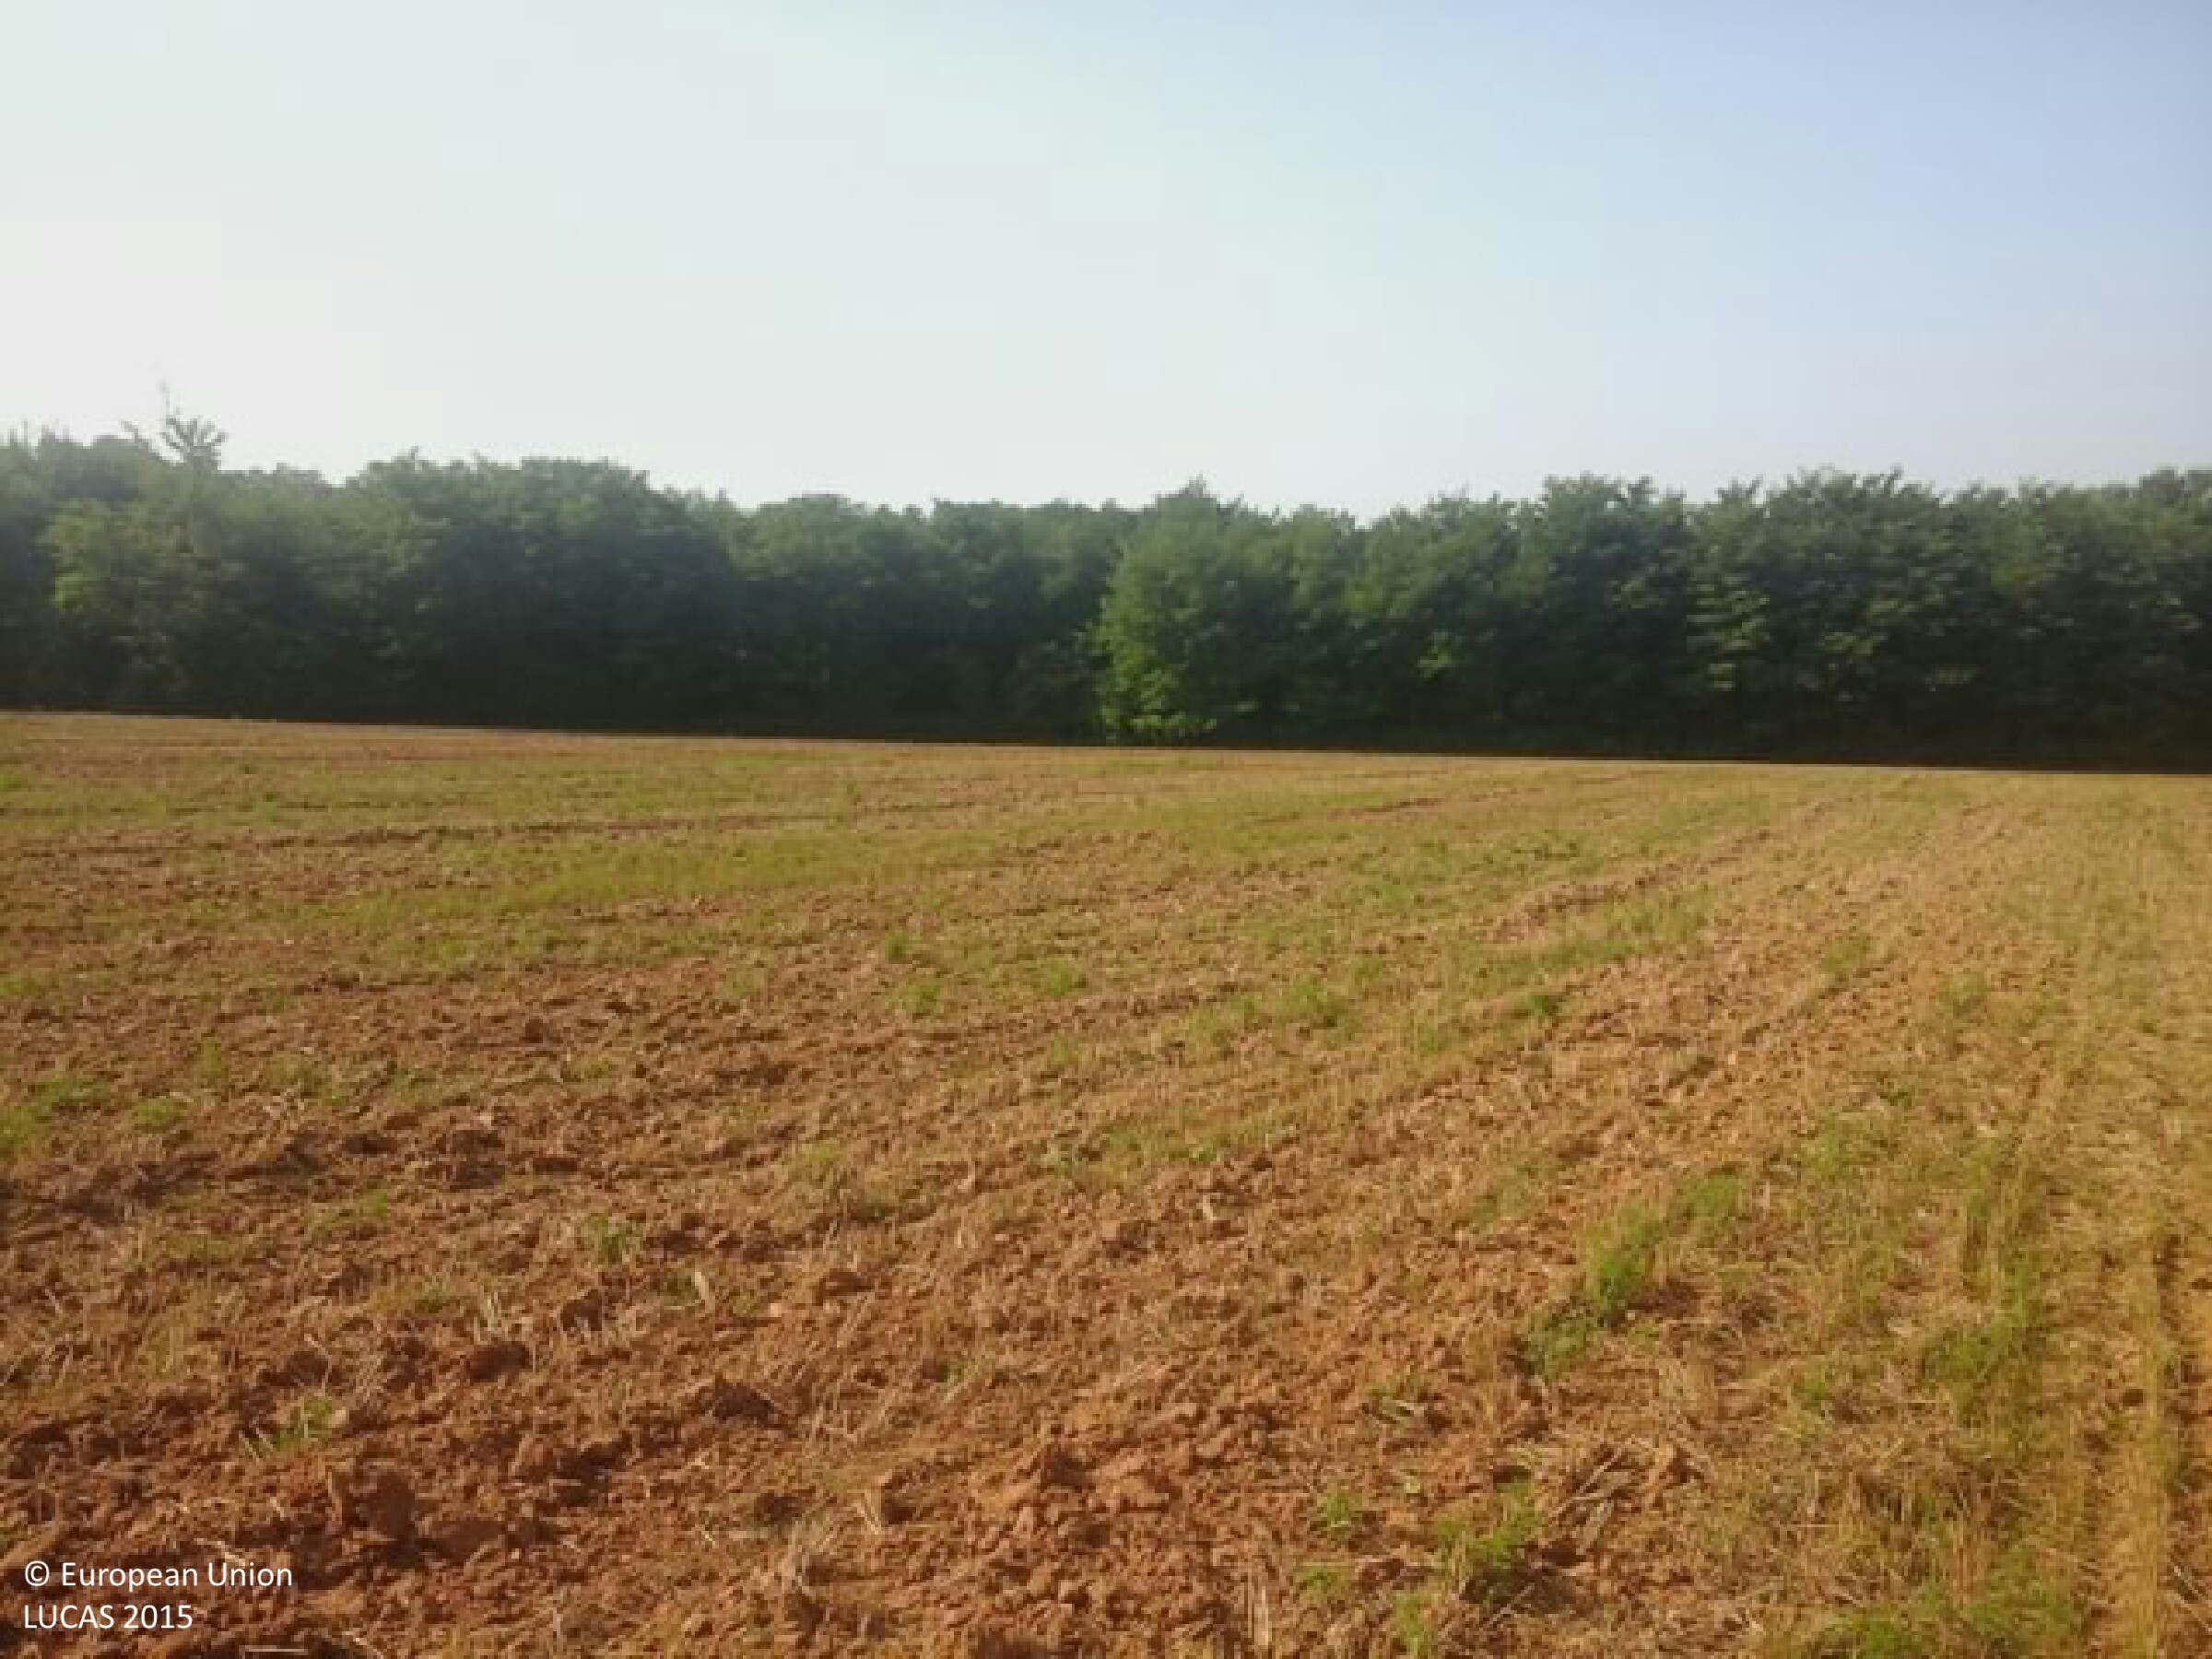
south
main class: Cropland
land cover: Triticale
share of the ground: < 10 %
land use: Agriculture (excluding fallow land and kitchen gardens)
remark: Harvested field
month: August
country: HU
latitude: 46.3611
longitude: 18.2093
